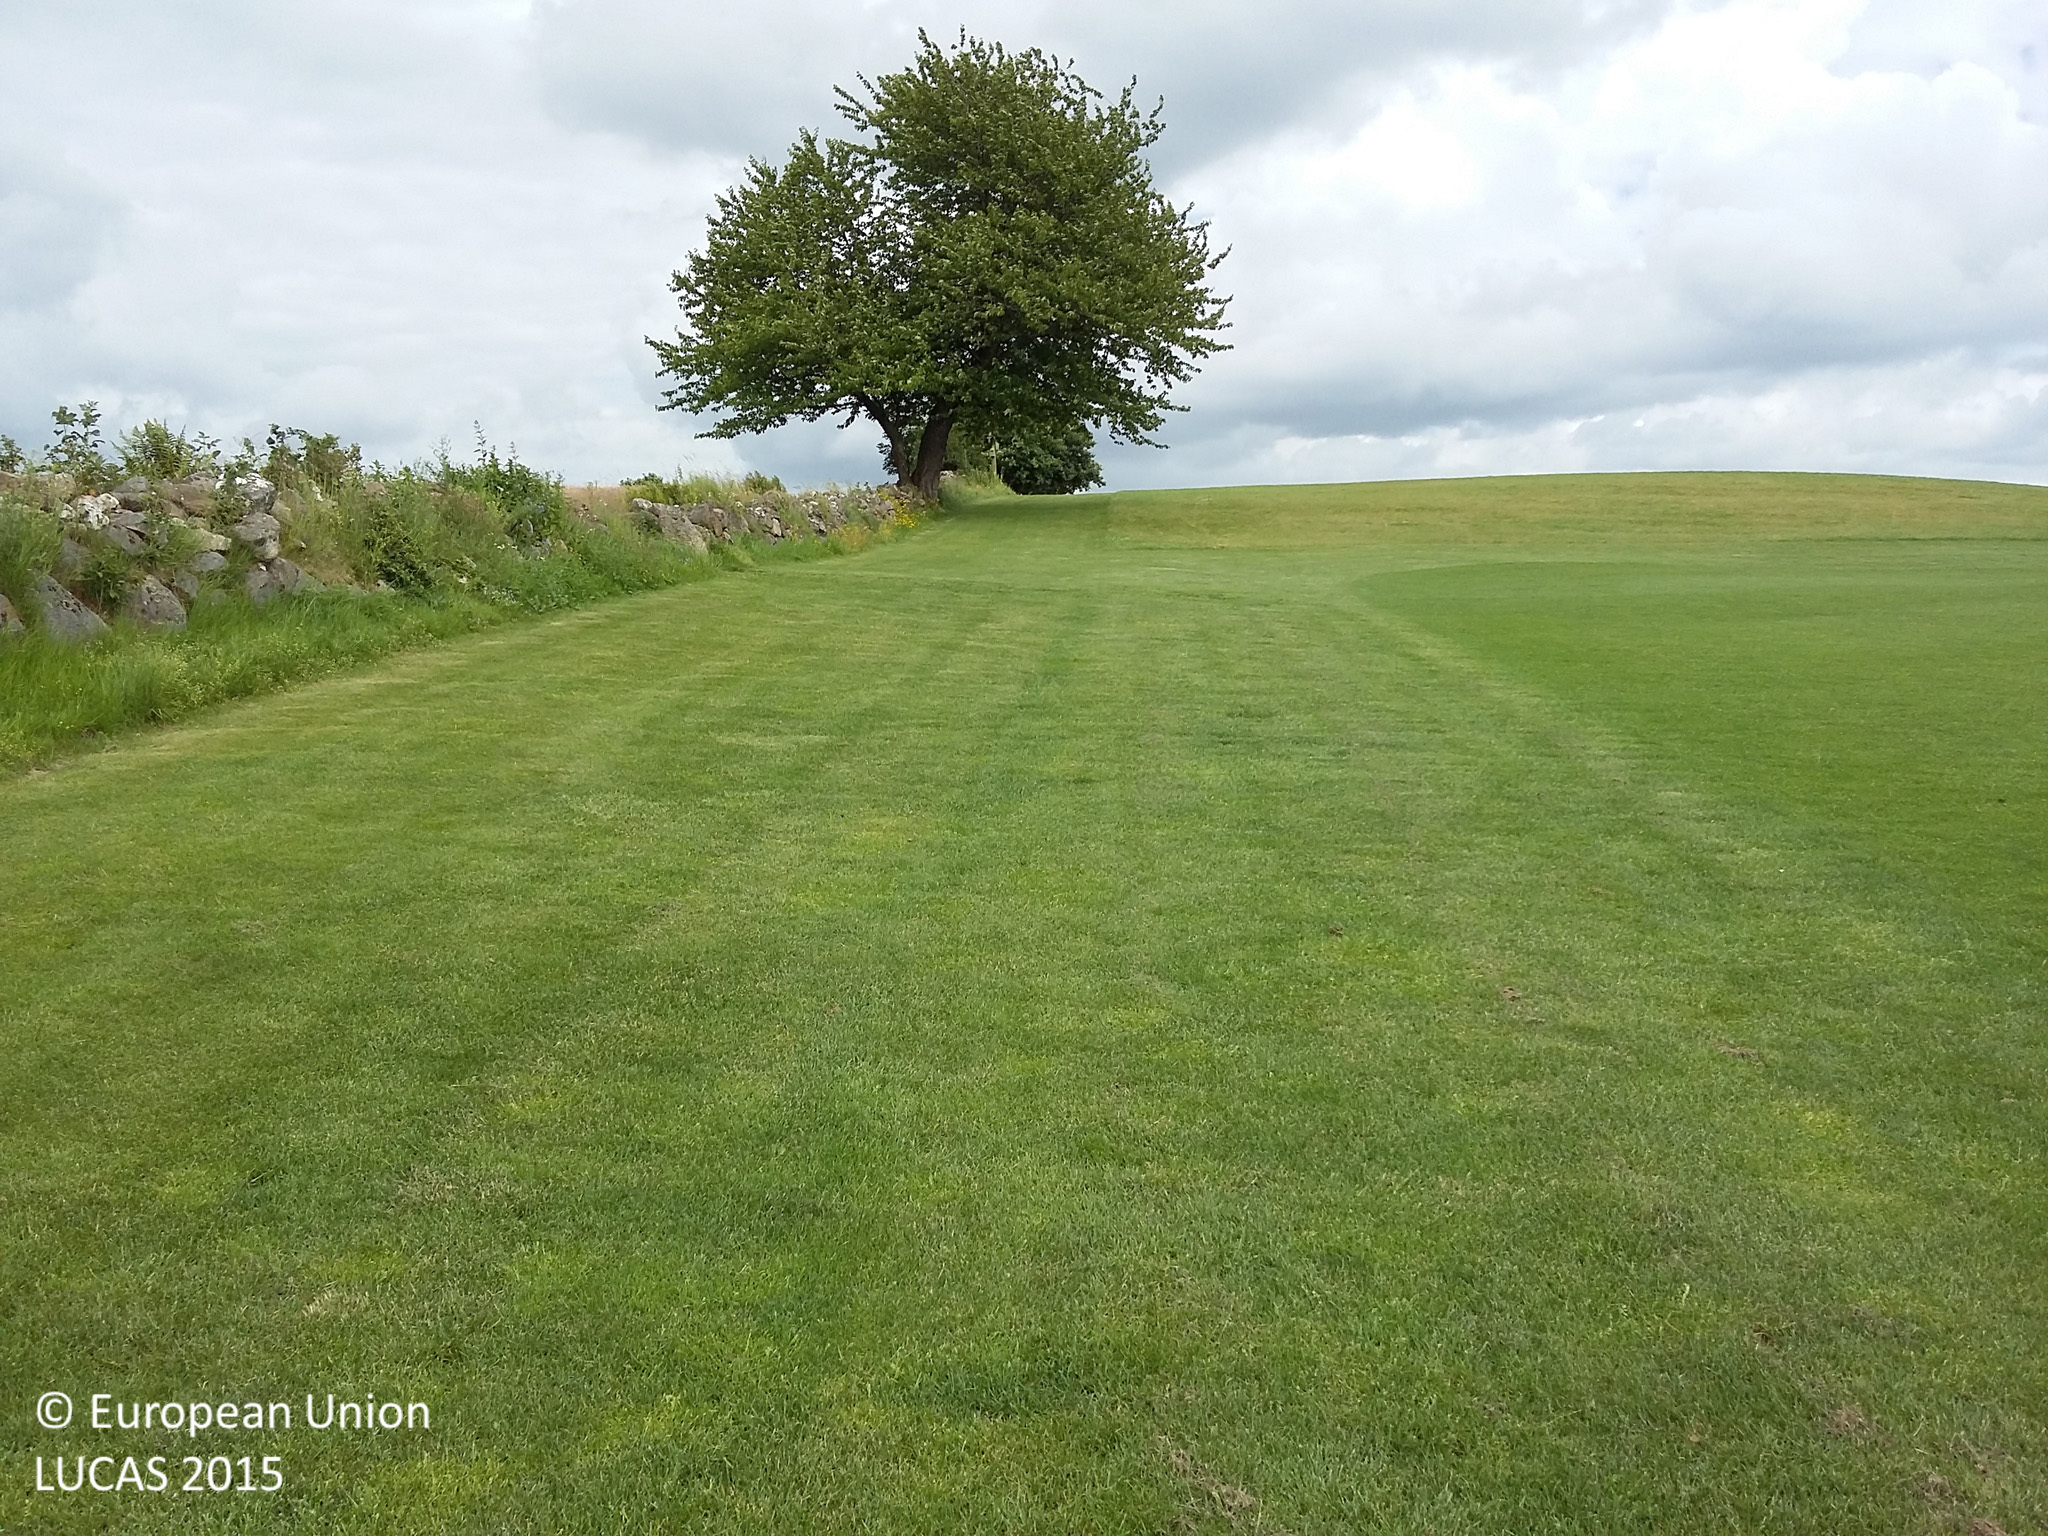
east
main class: Grassland
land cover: Grassland without tree/shrub cover
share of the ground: > 75 %
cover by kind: herbaceous plants 100 %
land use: Sport
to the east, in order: Grassland without tree/shrub cover; Dry stone walls; Single bushes/trees; Grassland without tree/shrub cover; Dry stone walls; Shruby margins; Fences; Spontaneously vegetated surfaces; Apple fruit
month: July
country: DK
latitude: 55.3872
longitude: 11.5615
